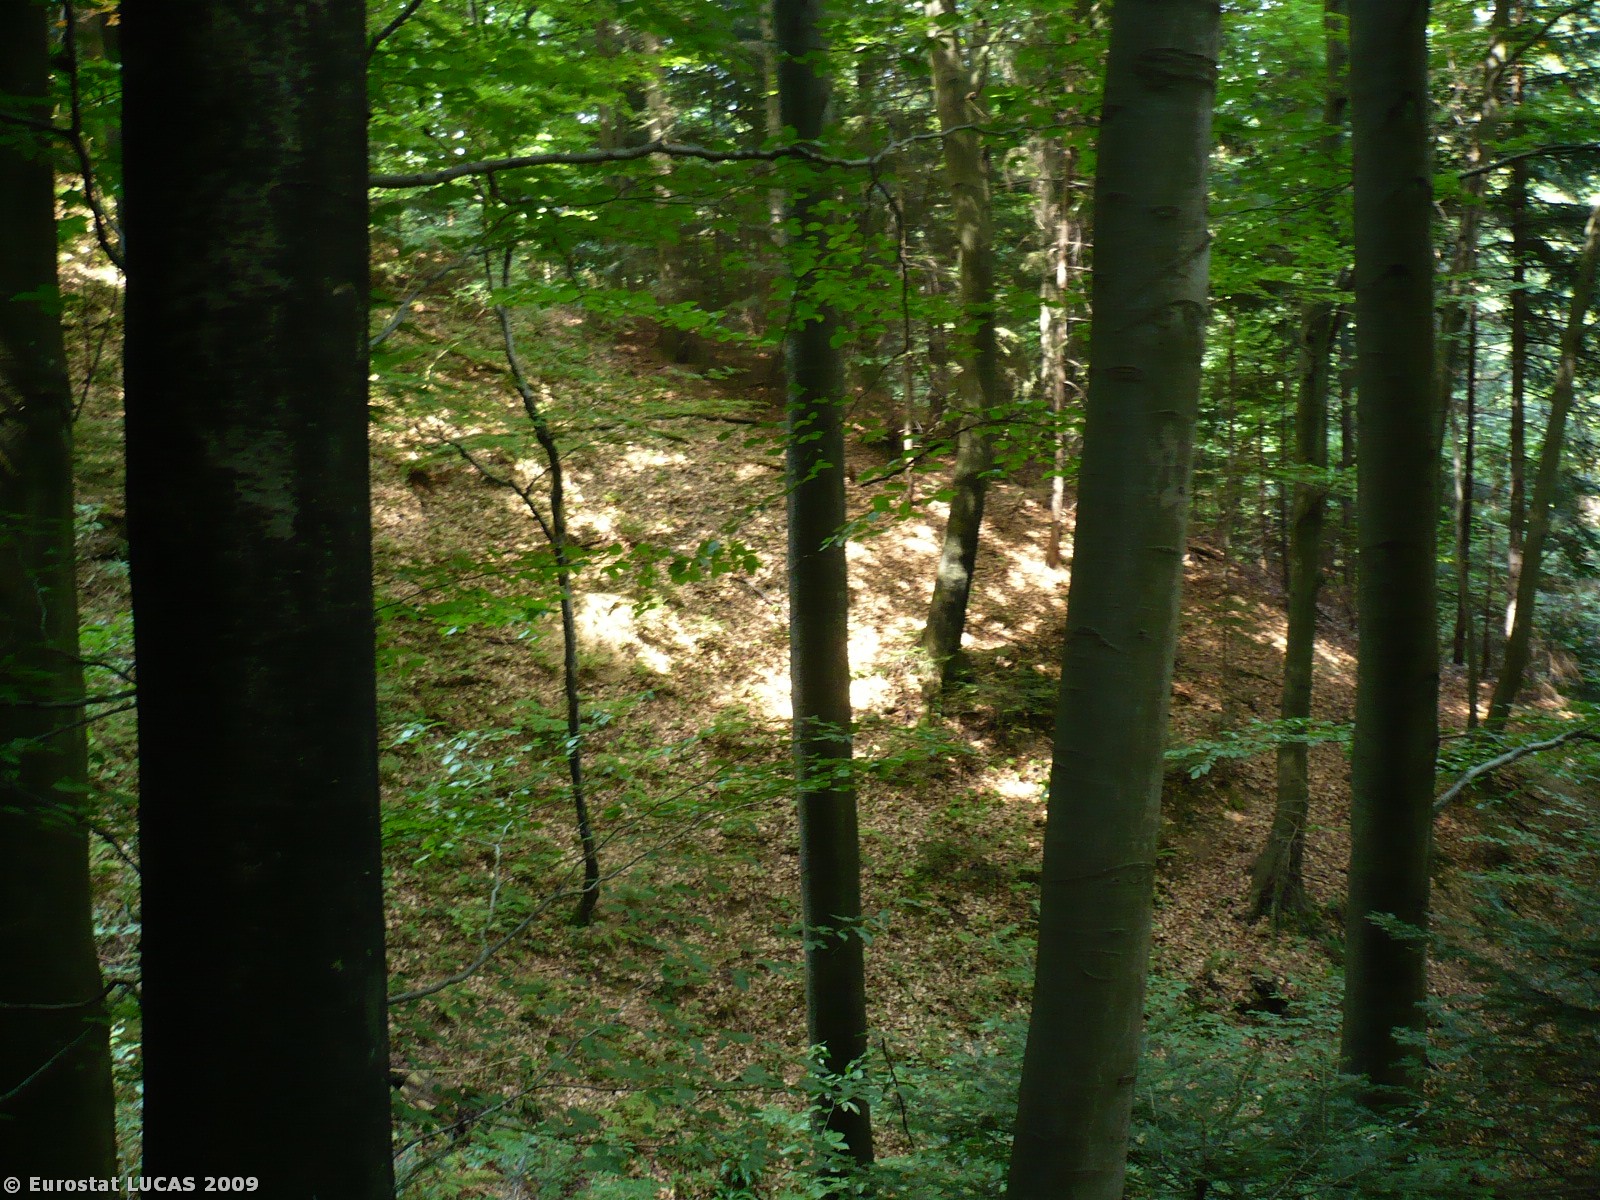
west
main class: Woodland
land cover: Mixed woodland
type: beech forest
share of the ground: > 75 %
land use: Forestry
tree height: > 5 m
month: August
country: SI
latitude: 46.3058
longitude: 15.3864
